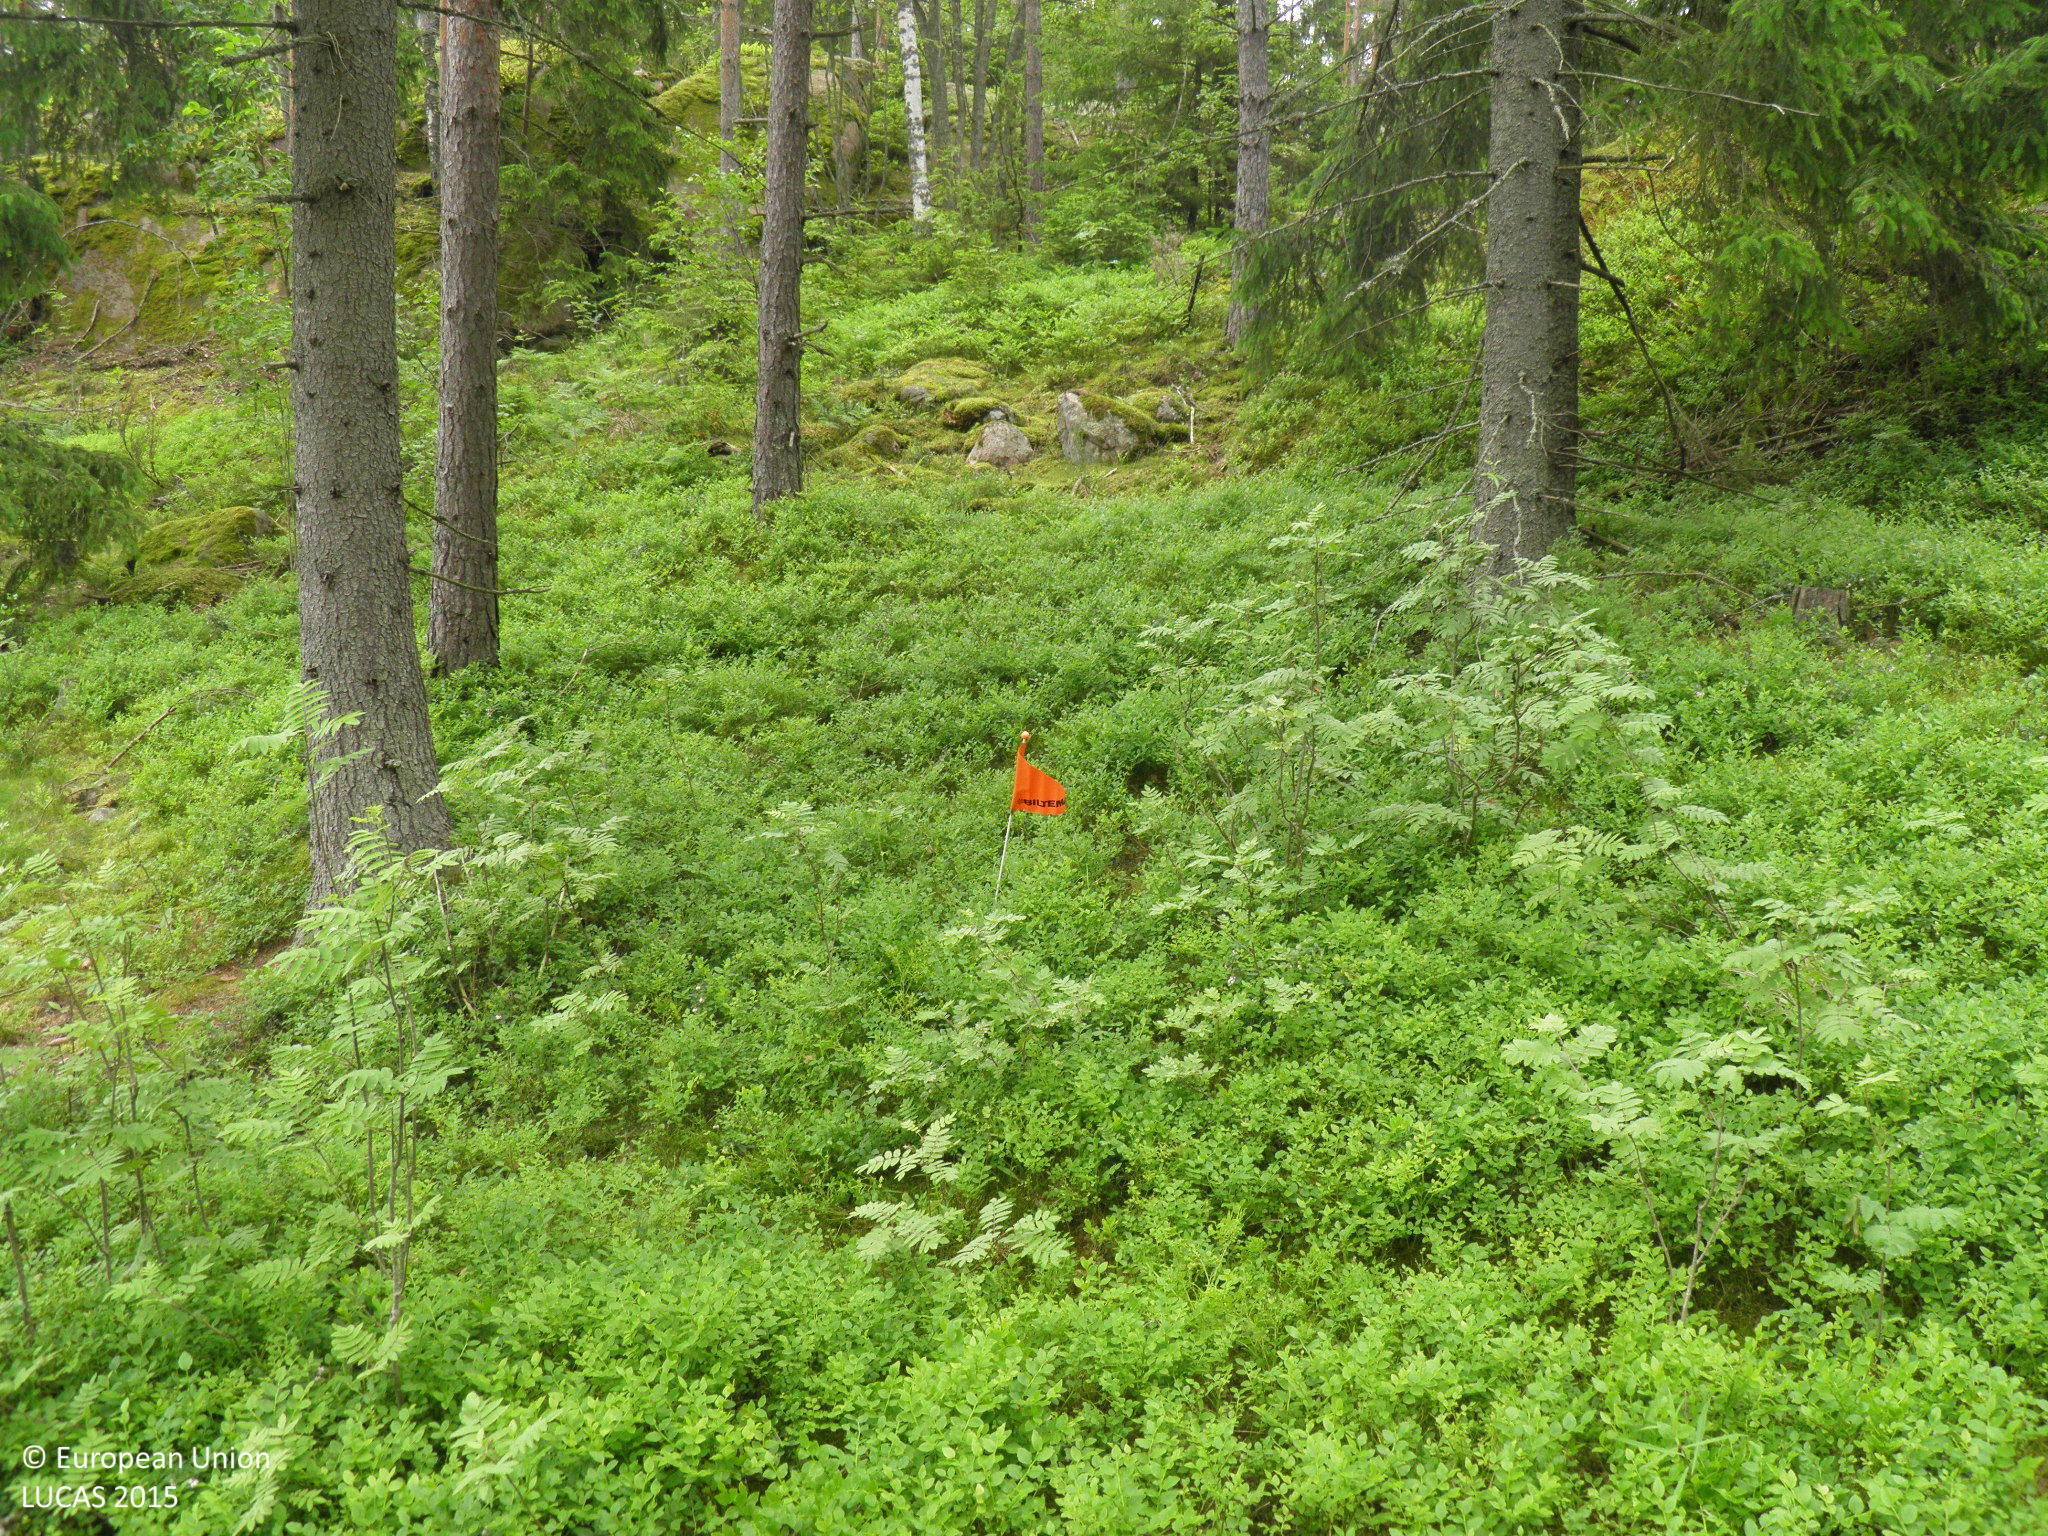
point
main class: Woodland
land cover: Other coniferous woodland
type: hemiboreal forest and nemoral coniferous forest and mixed broadleaved-coniferous forest
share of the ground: > 75 %
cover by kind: coniferous forest trees 70 %, broadleaved forest trees 10 %, shrubs 10 %, herbaceous plants 10 %
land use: Forestry
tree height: > 5 m
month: June
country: FI
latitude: 60.3079
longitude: 22.1746
